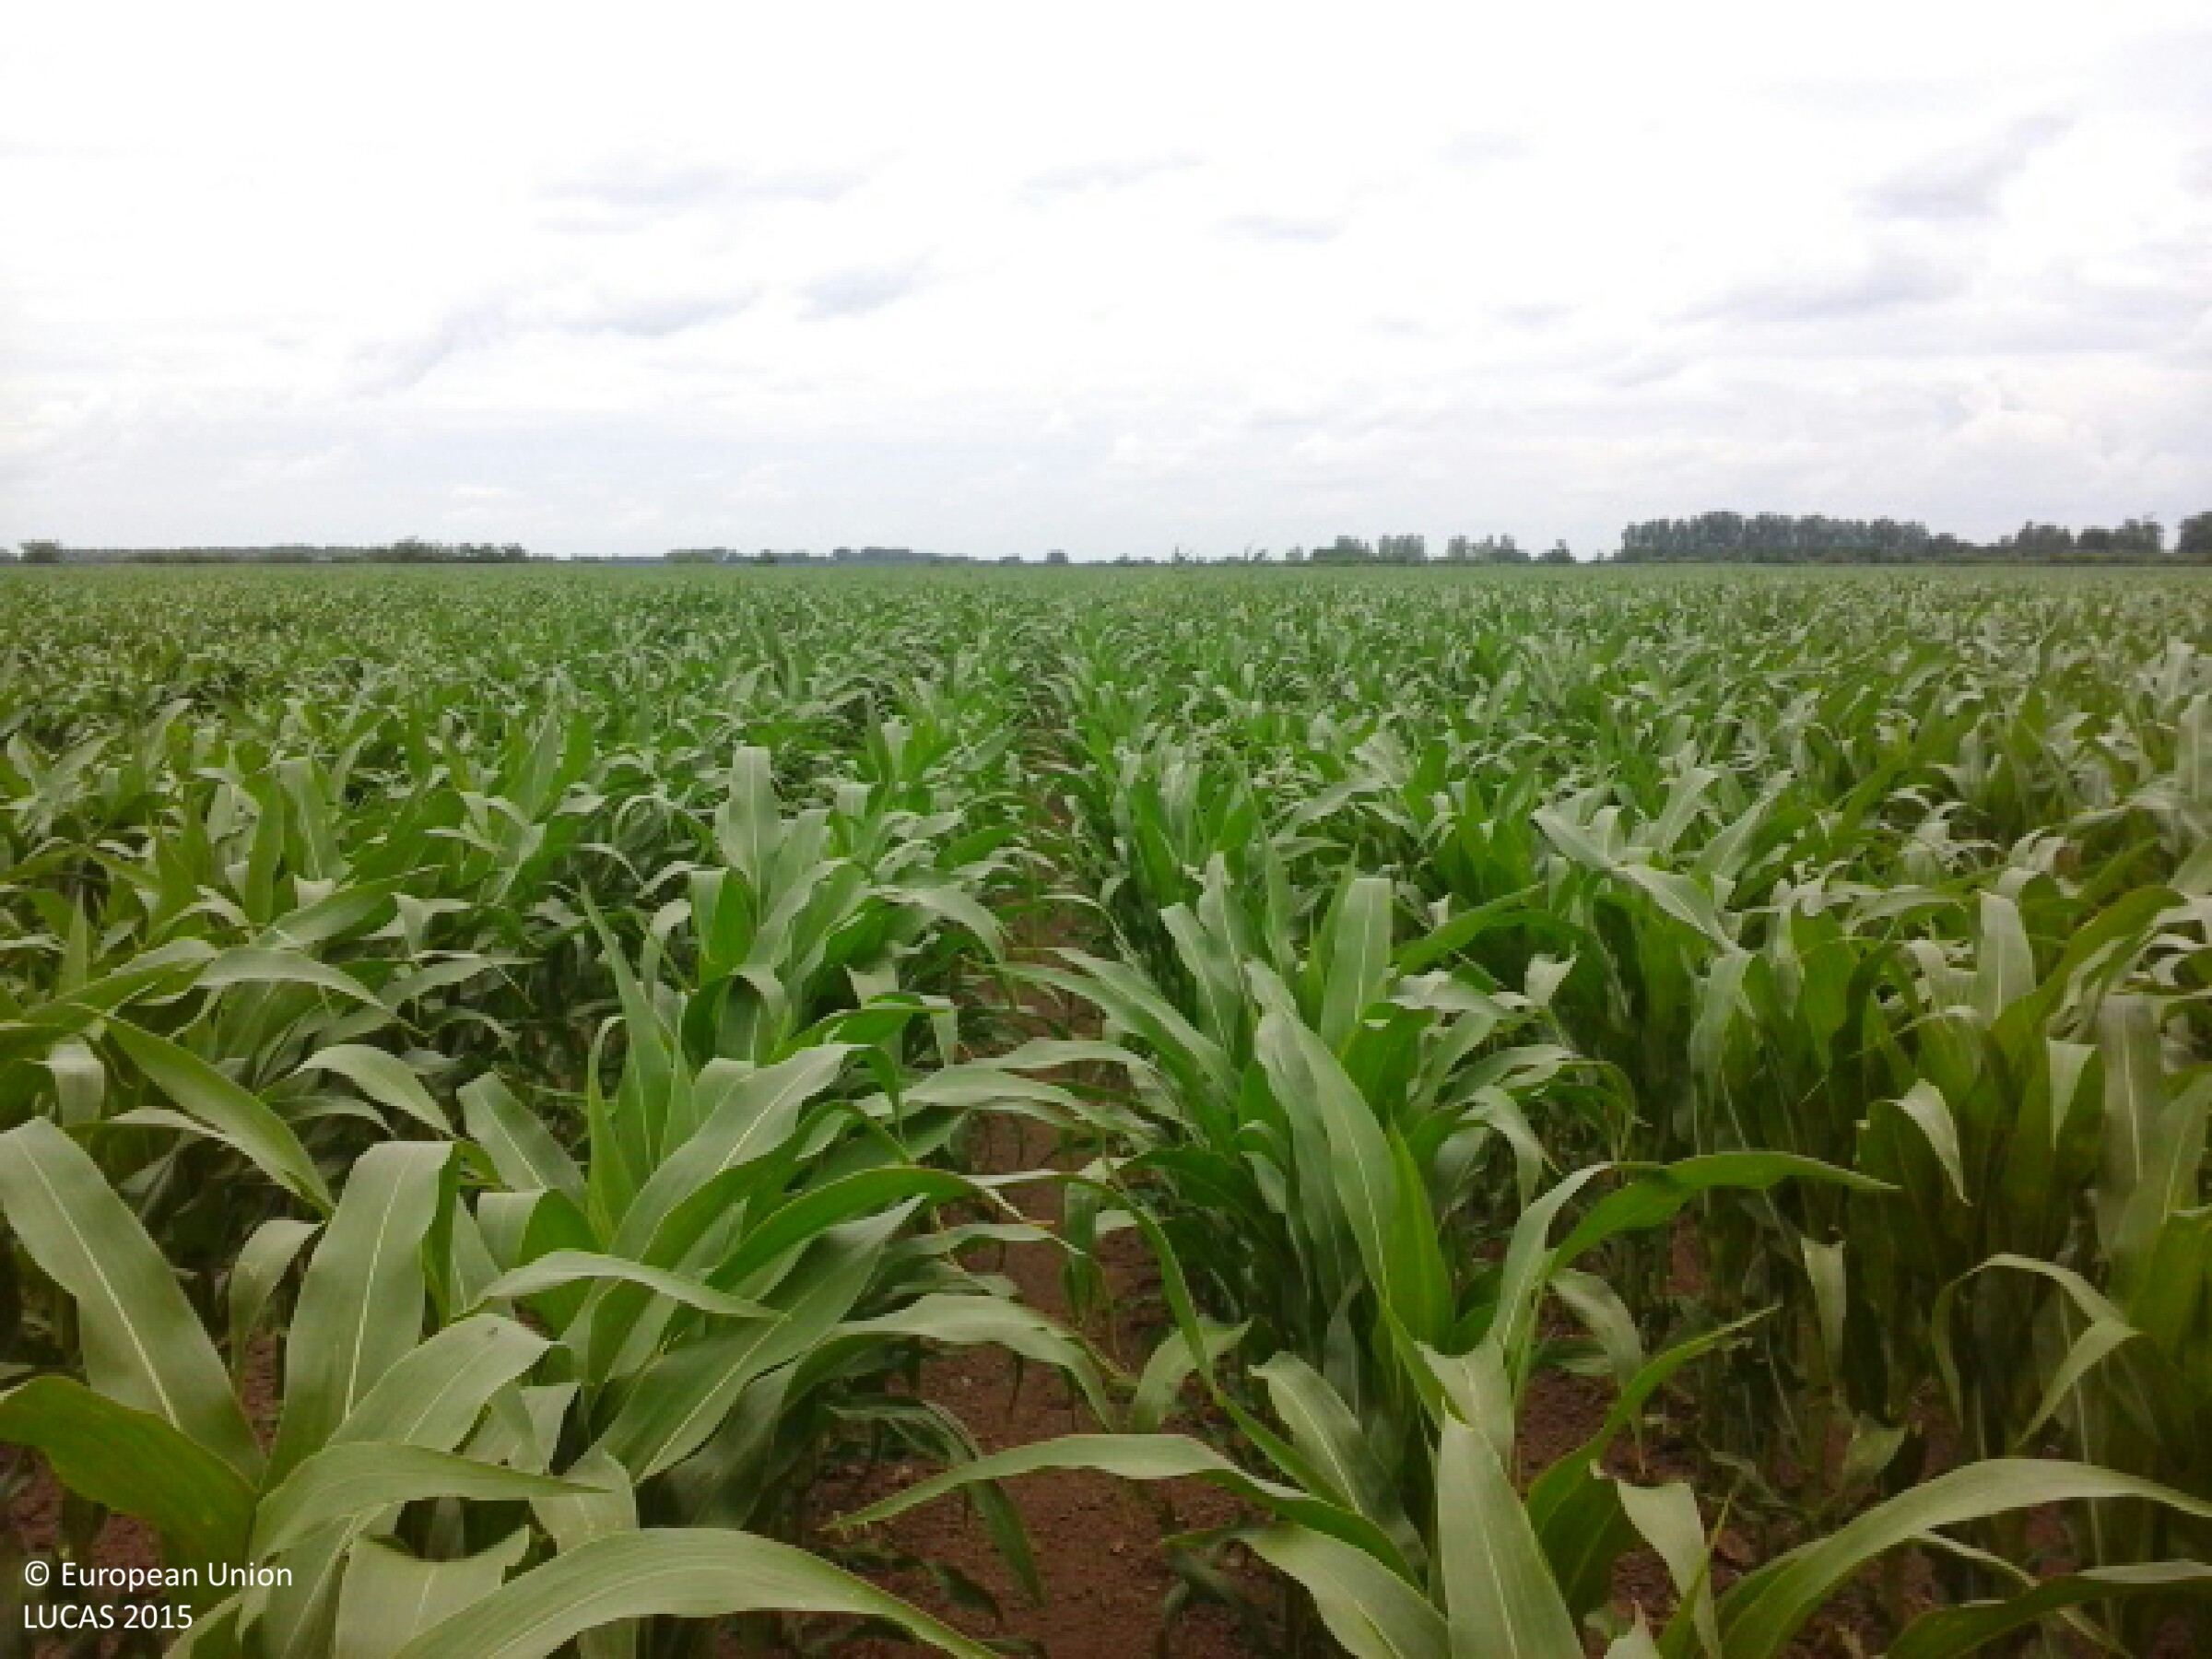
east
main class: Cropland
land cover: Maize
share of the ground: 50 - 75 %
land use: Agriculture (excluding fallow land and kitchen gardens)
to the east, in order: Maize
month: June
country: HU
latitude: 48.1583
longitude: 21.7315
